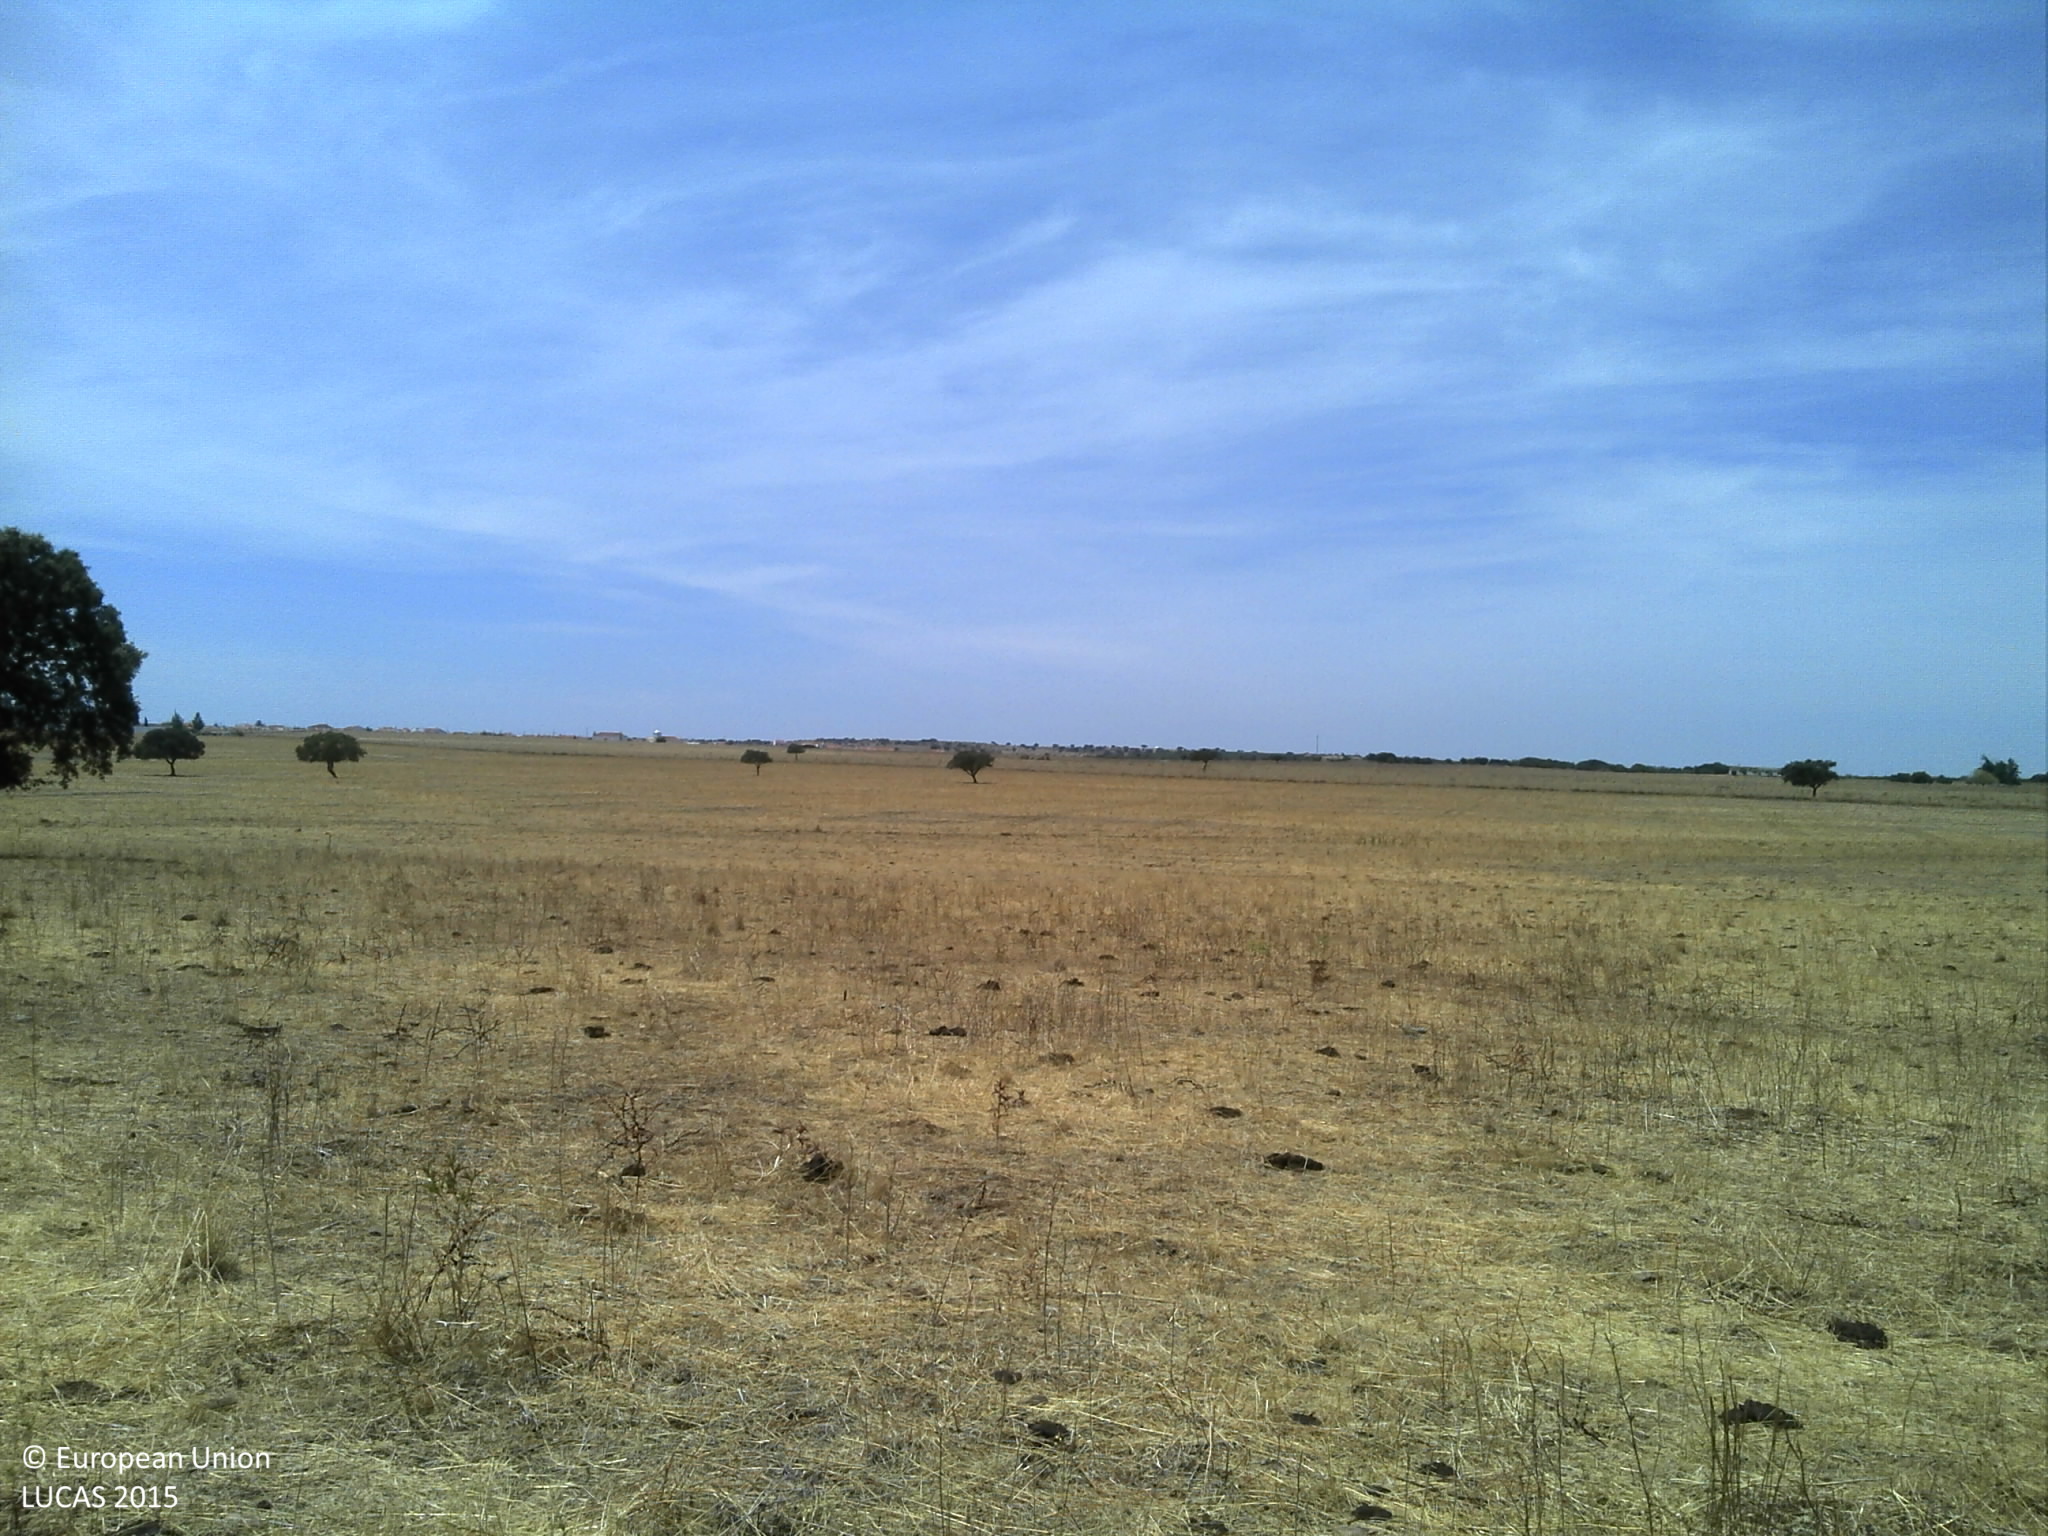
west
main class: Grassland
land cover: Spontaneously vegetated surfaces
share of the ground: 10 - 25 %
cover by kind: unconsolidated bare surface 90 %, herbaceous plants 10 %
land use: Agriculture (excluding fallow land and kitchen gardens)
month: July
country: PT
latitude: 38.3743
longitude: -7.4583
